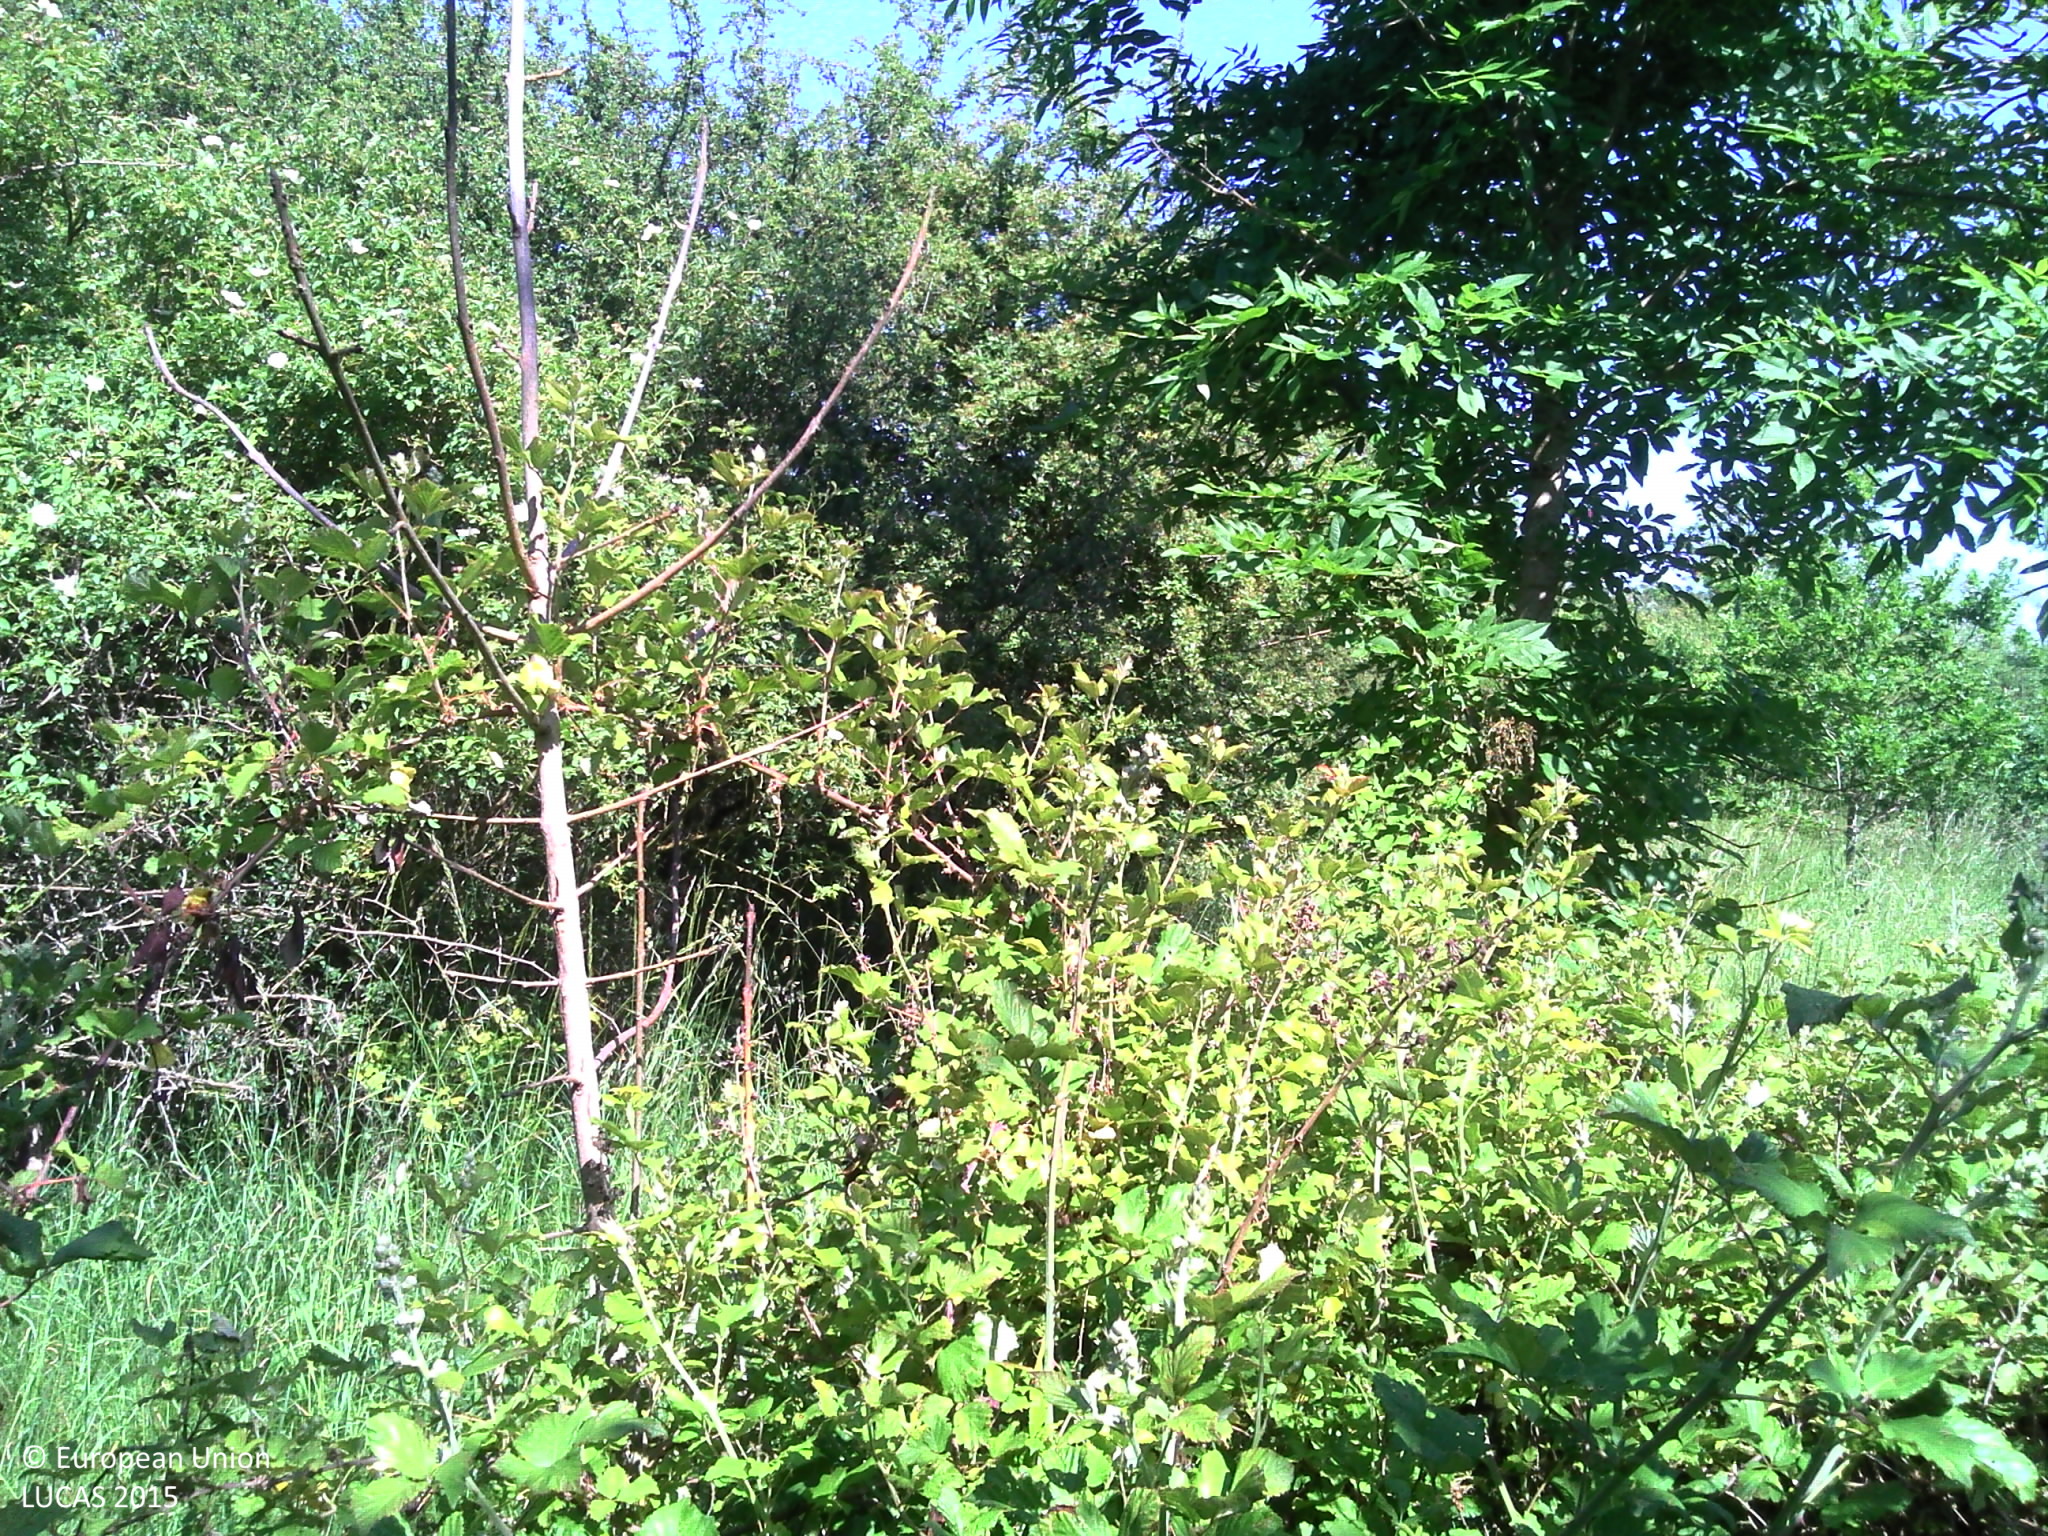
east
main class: Woodland
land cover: Broadleaved woodland
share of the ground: 50 - 75 %
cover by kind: broadleaved forest trees 70 %, herbaceous plants 30 %
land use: Semi-natural and natural areas not in use
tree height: < 5 m
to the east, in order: Broadleaved woodland; Fences; Grass margins; Paved roads, cycling and walking lanes; Grass margins; Ditches and canals; Grass margins; Common wheat; Fences; Grassland without tree/shrub cover; Fences; Managed hedges; Triticale
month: June
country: FR
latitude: 47.5522
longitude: 3.9513
